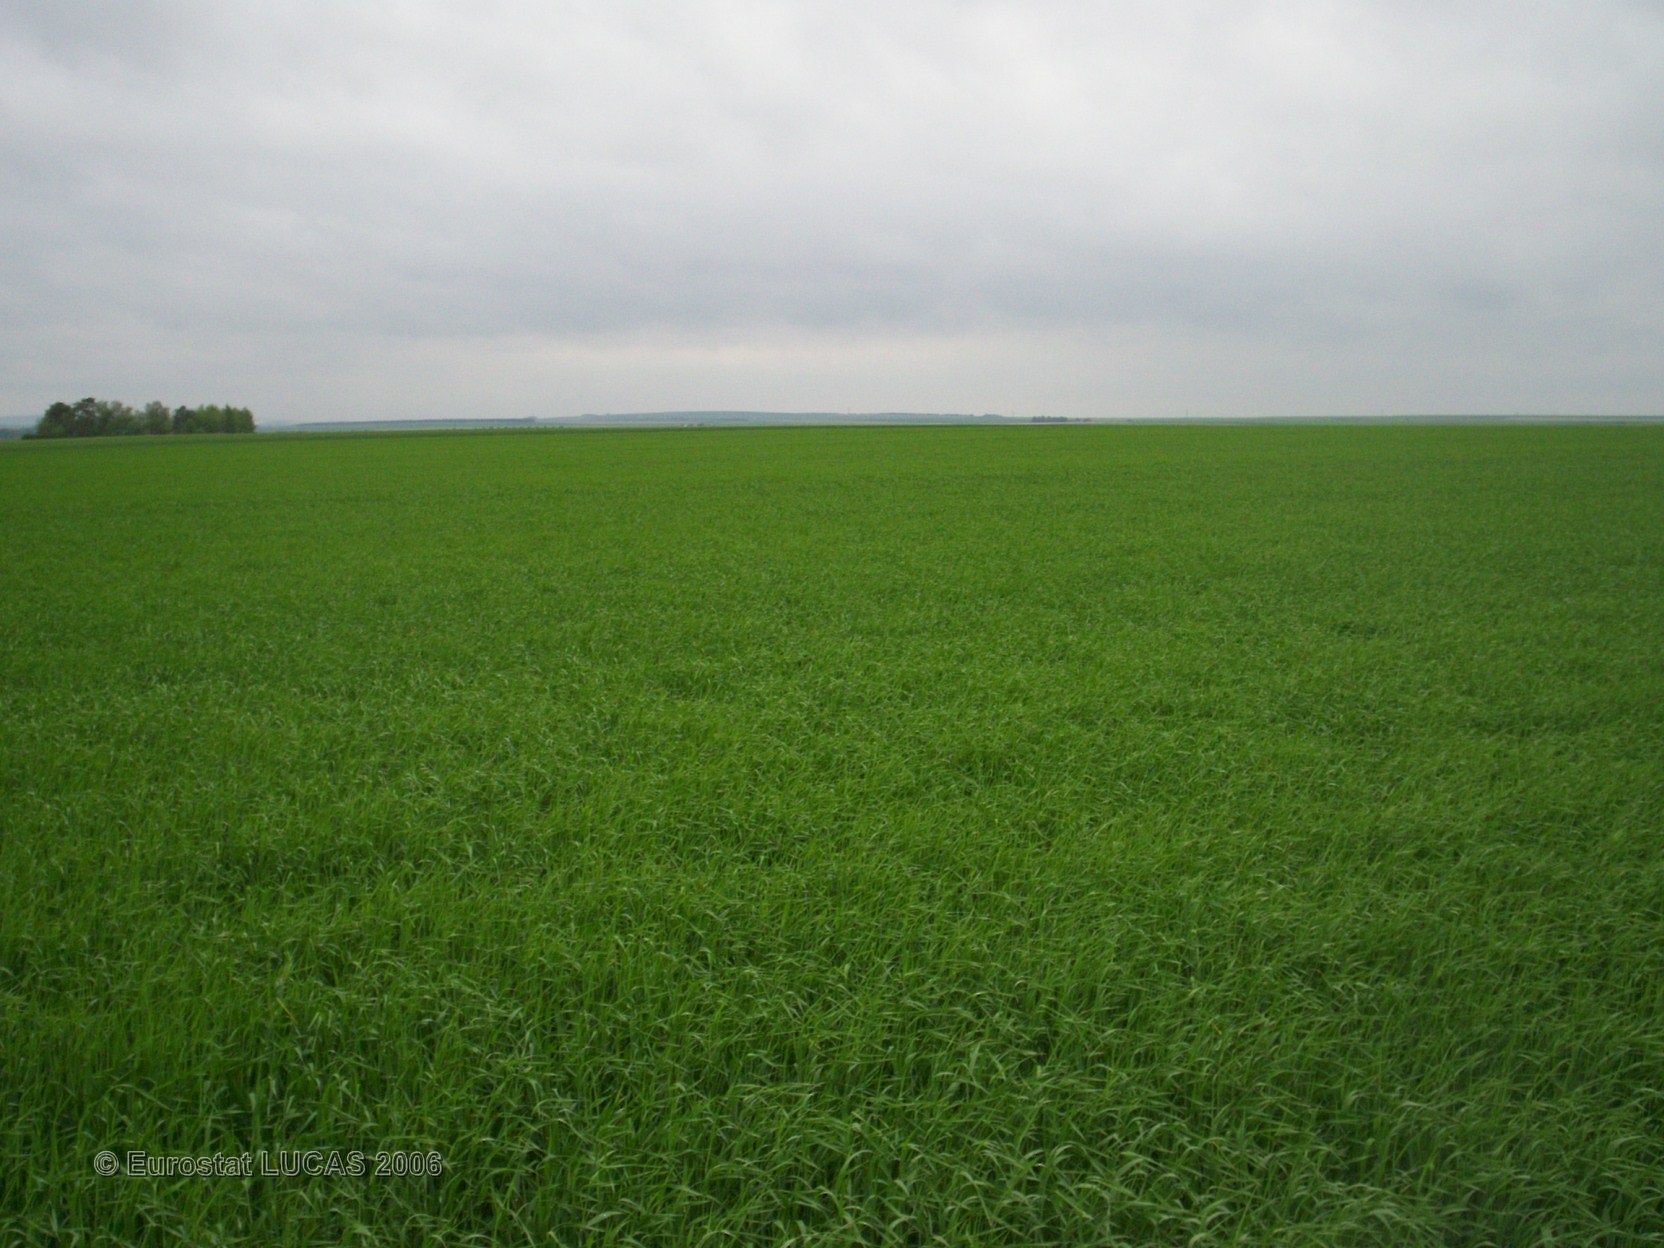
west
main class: Cropland
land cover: Barley
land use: Agriculture (excluding fallow land and kitchen gardens)
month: May
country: FR
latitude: 49.3102
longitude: 4.4531
